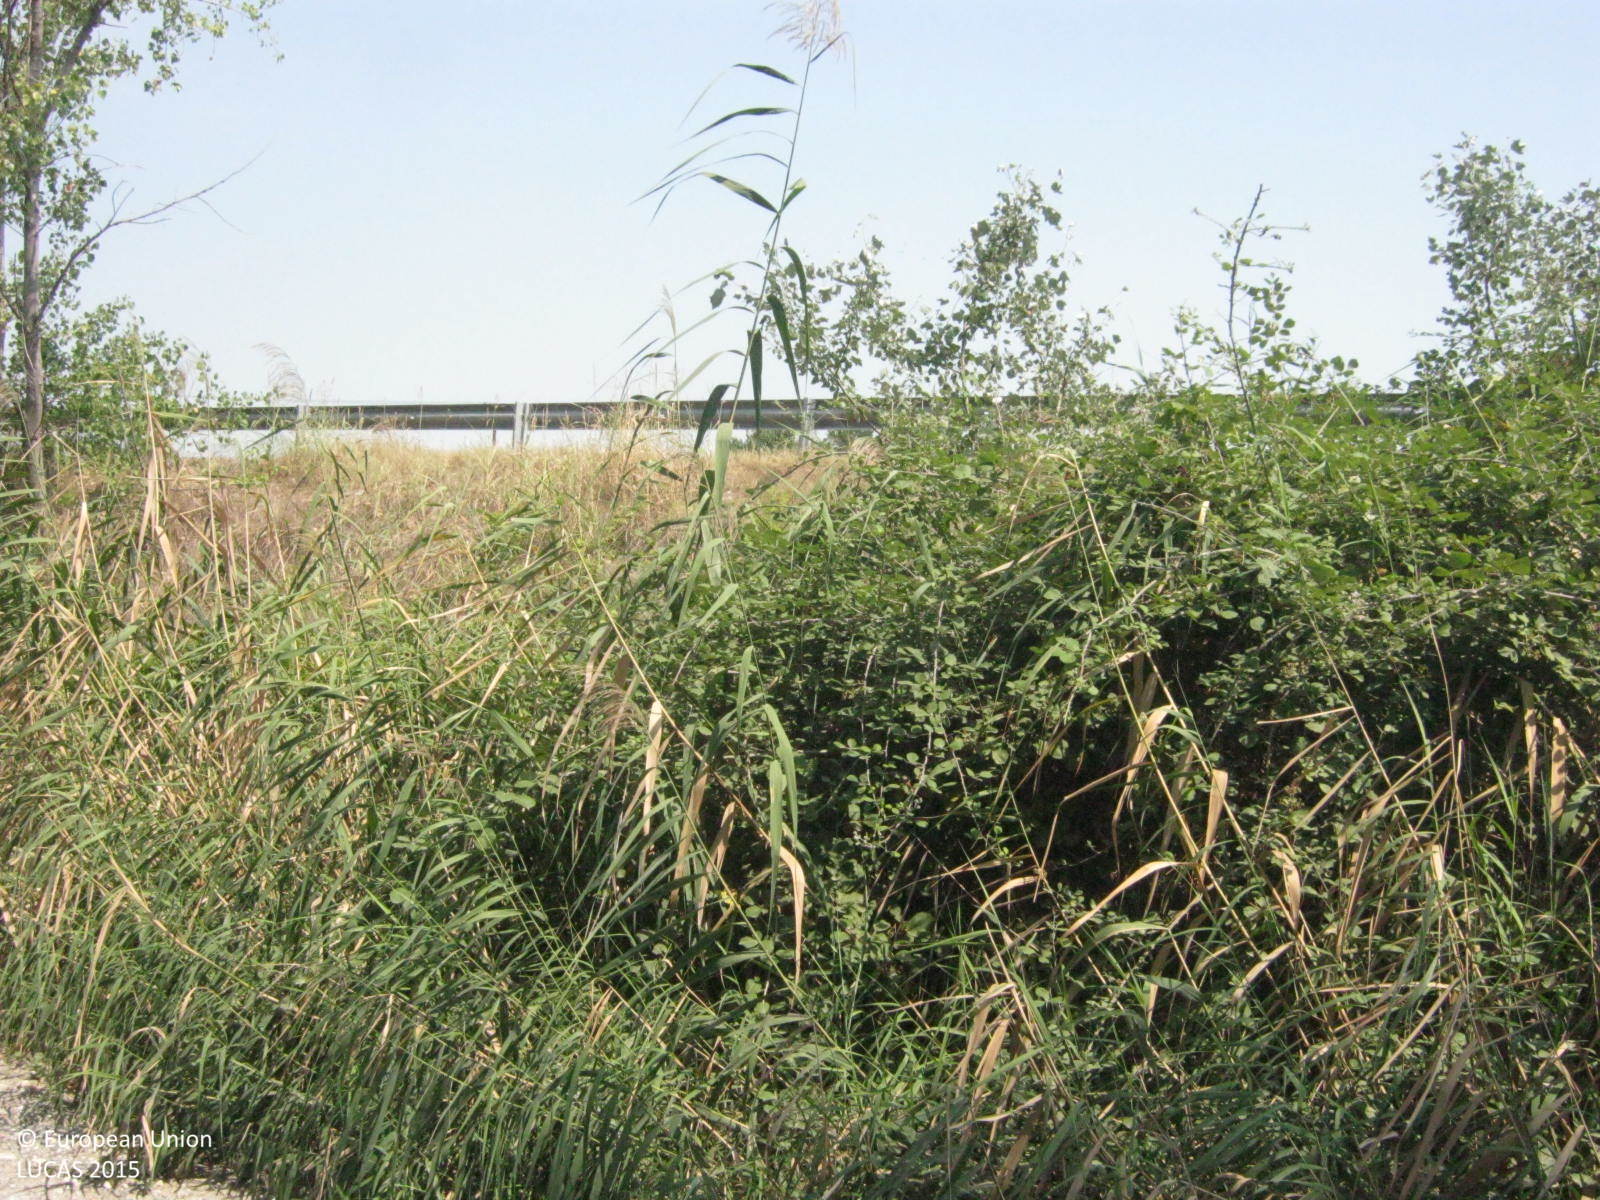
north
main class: Woodland
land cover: Broadleaved woodland
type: floodplain forest
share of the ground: > 75 %
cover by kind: broadleaved forest trees 100 %
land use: Semi-natural and natural areas not in use
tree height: > 5 m
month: August
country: GR
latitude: 40.5603
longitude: 22.5087
